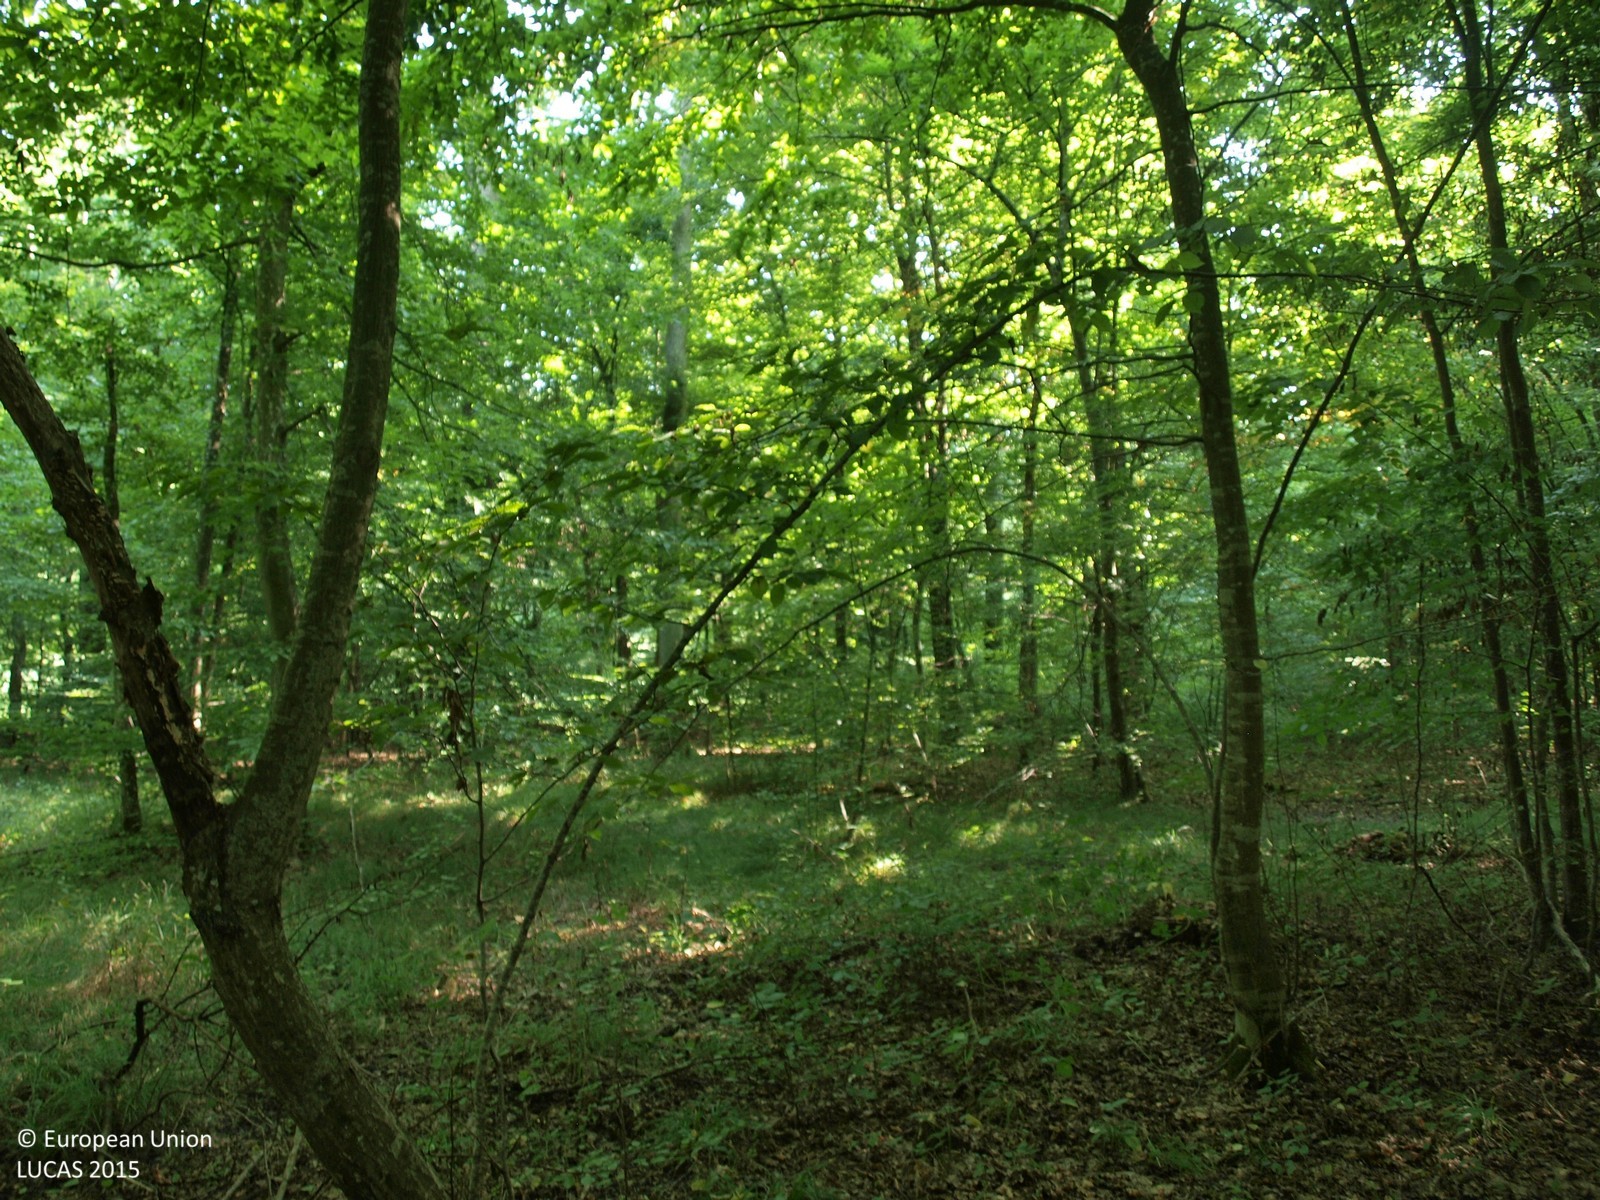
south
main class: Woodland
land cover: Broadleaved woodland
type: mesophytic deciduous forest
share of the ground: > 75 %
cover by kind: broadleaved forest trees 100 %
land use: Forestry
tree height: > 5 m
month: August
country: HR
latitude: 45.8904
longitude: 16.6624
